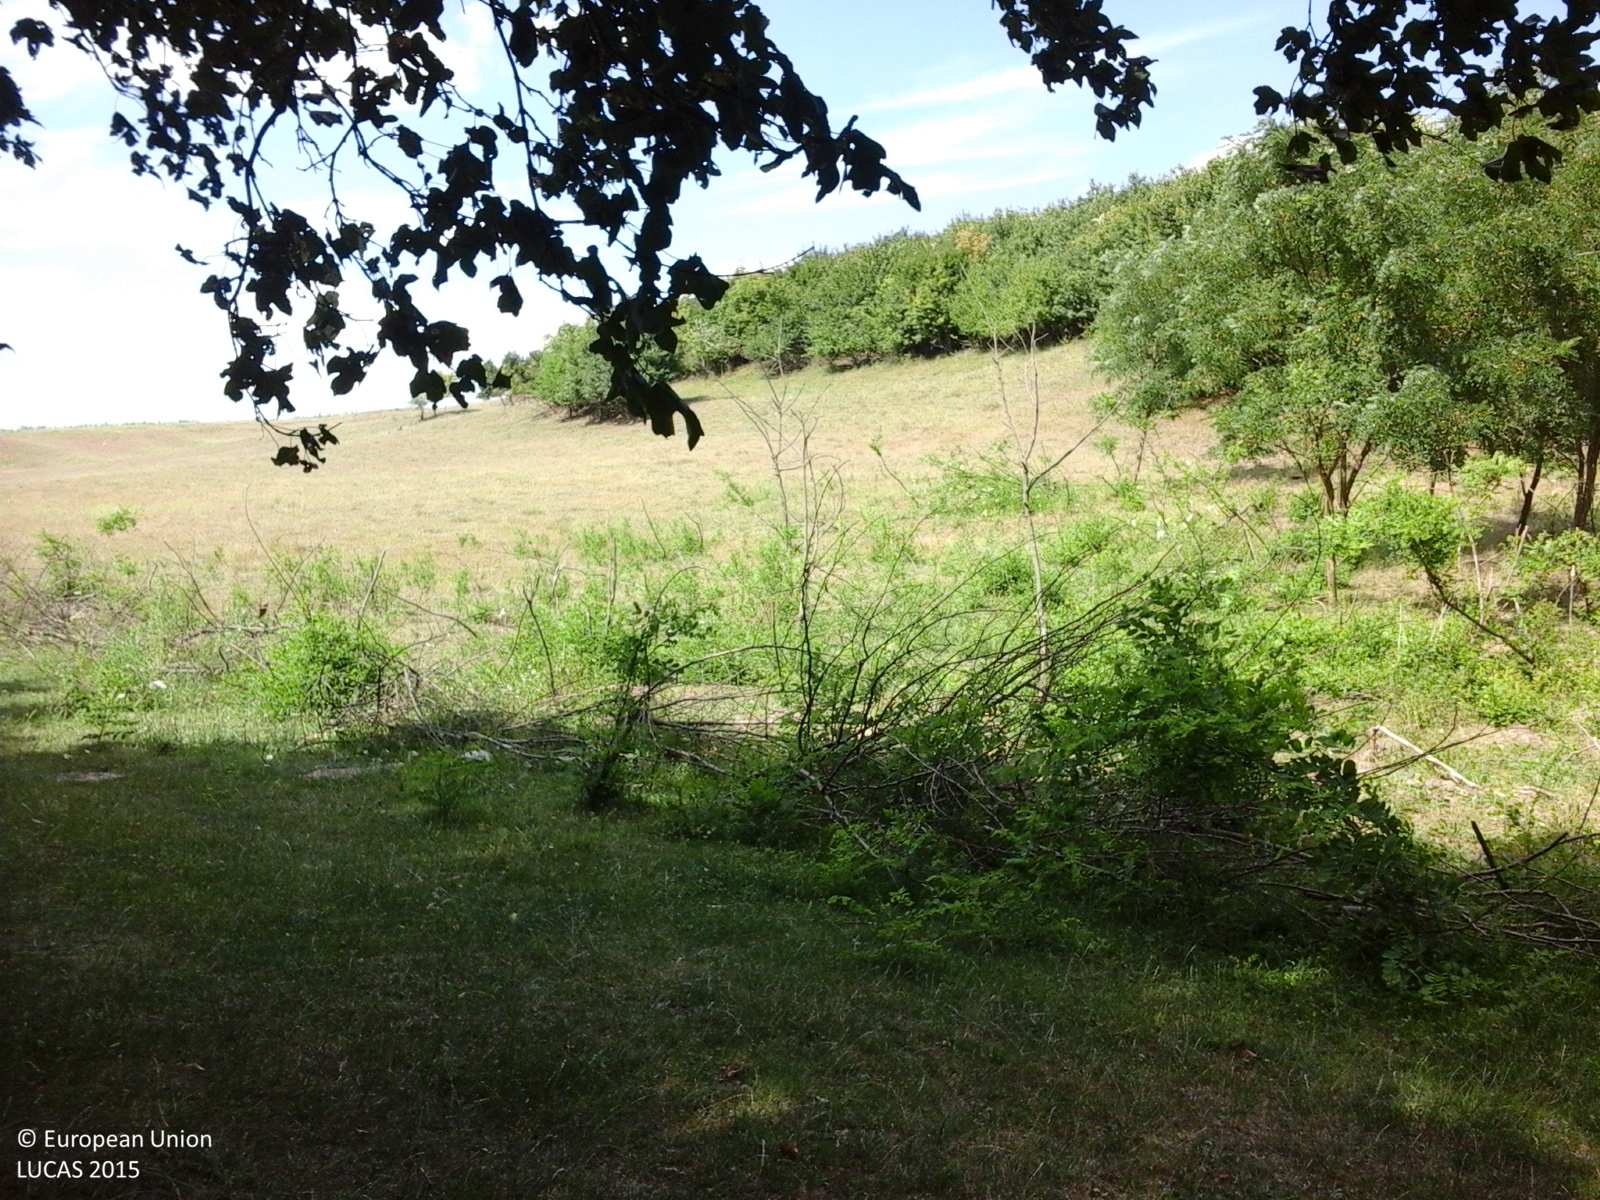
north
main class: Woodland
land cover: Broadleaved woodland
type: mesophytic deciduous forest
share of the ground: > 75 %
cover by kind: broadleaved forest trees 100 %
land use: Forestry
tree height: > 5 m
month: July
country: RO
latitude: 45.9952
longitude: 27.6313
